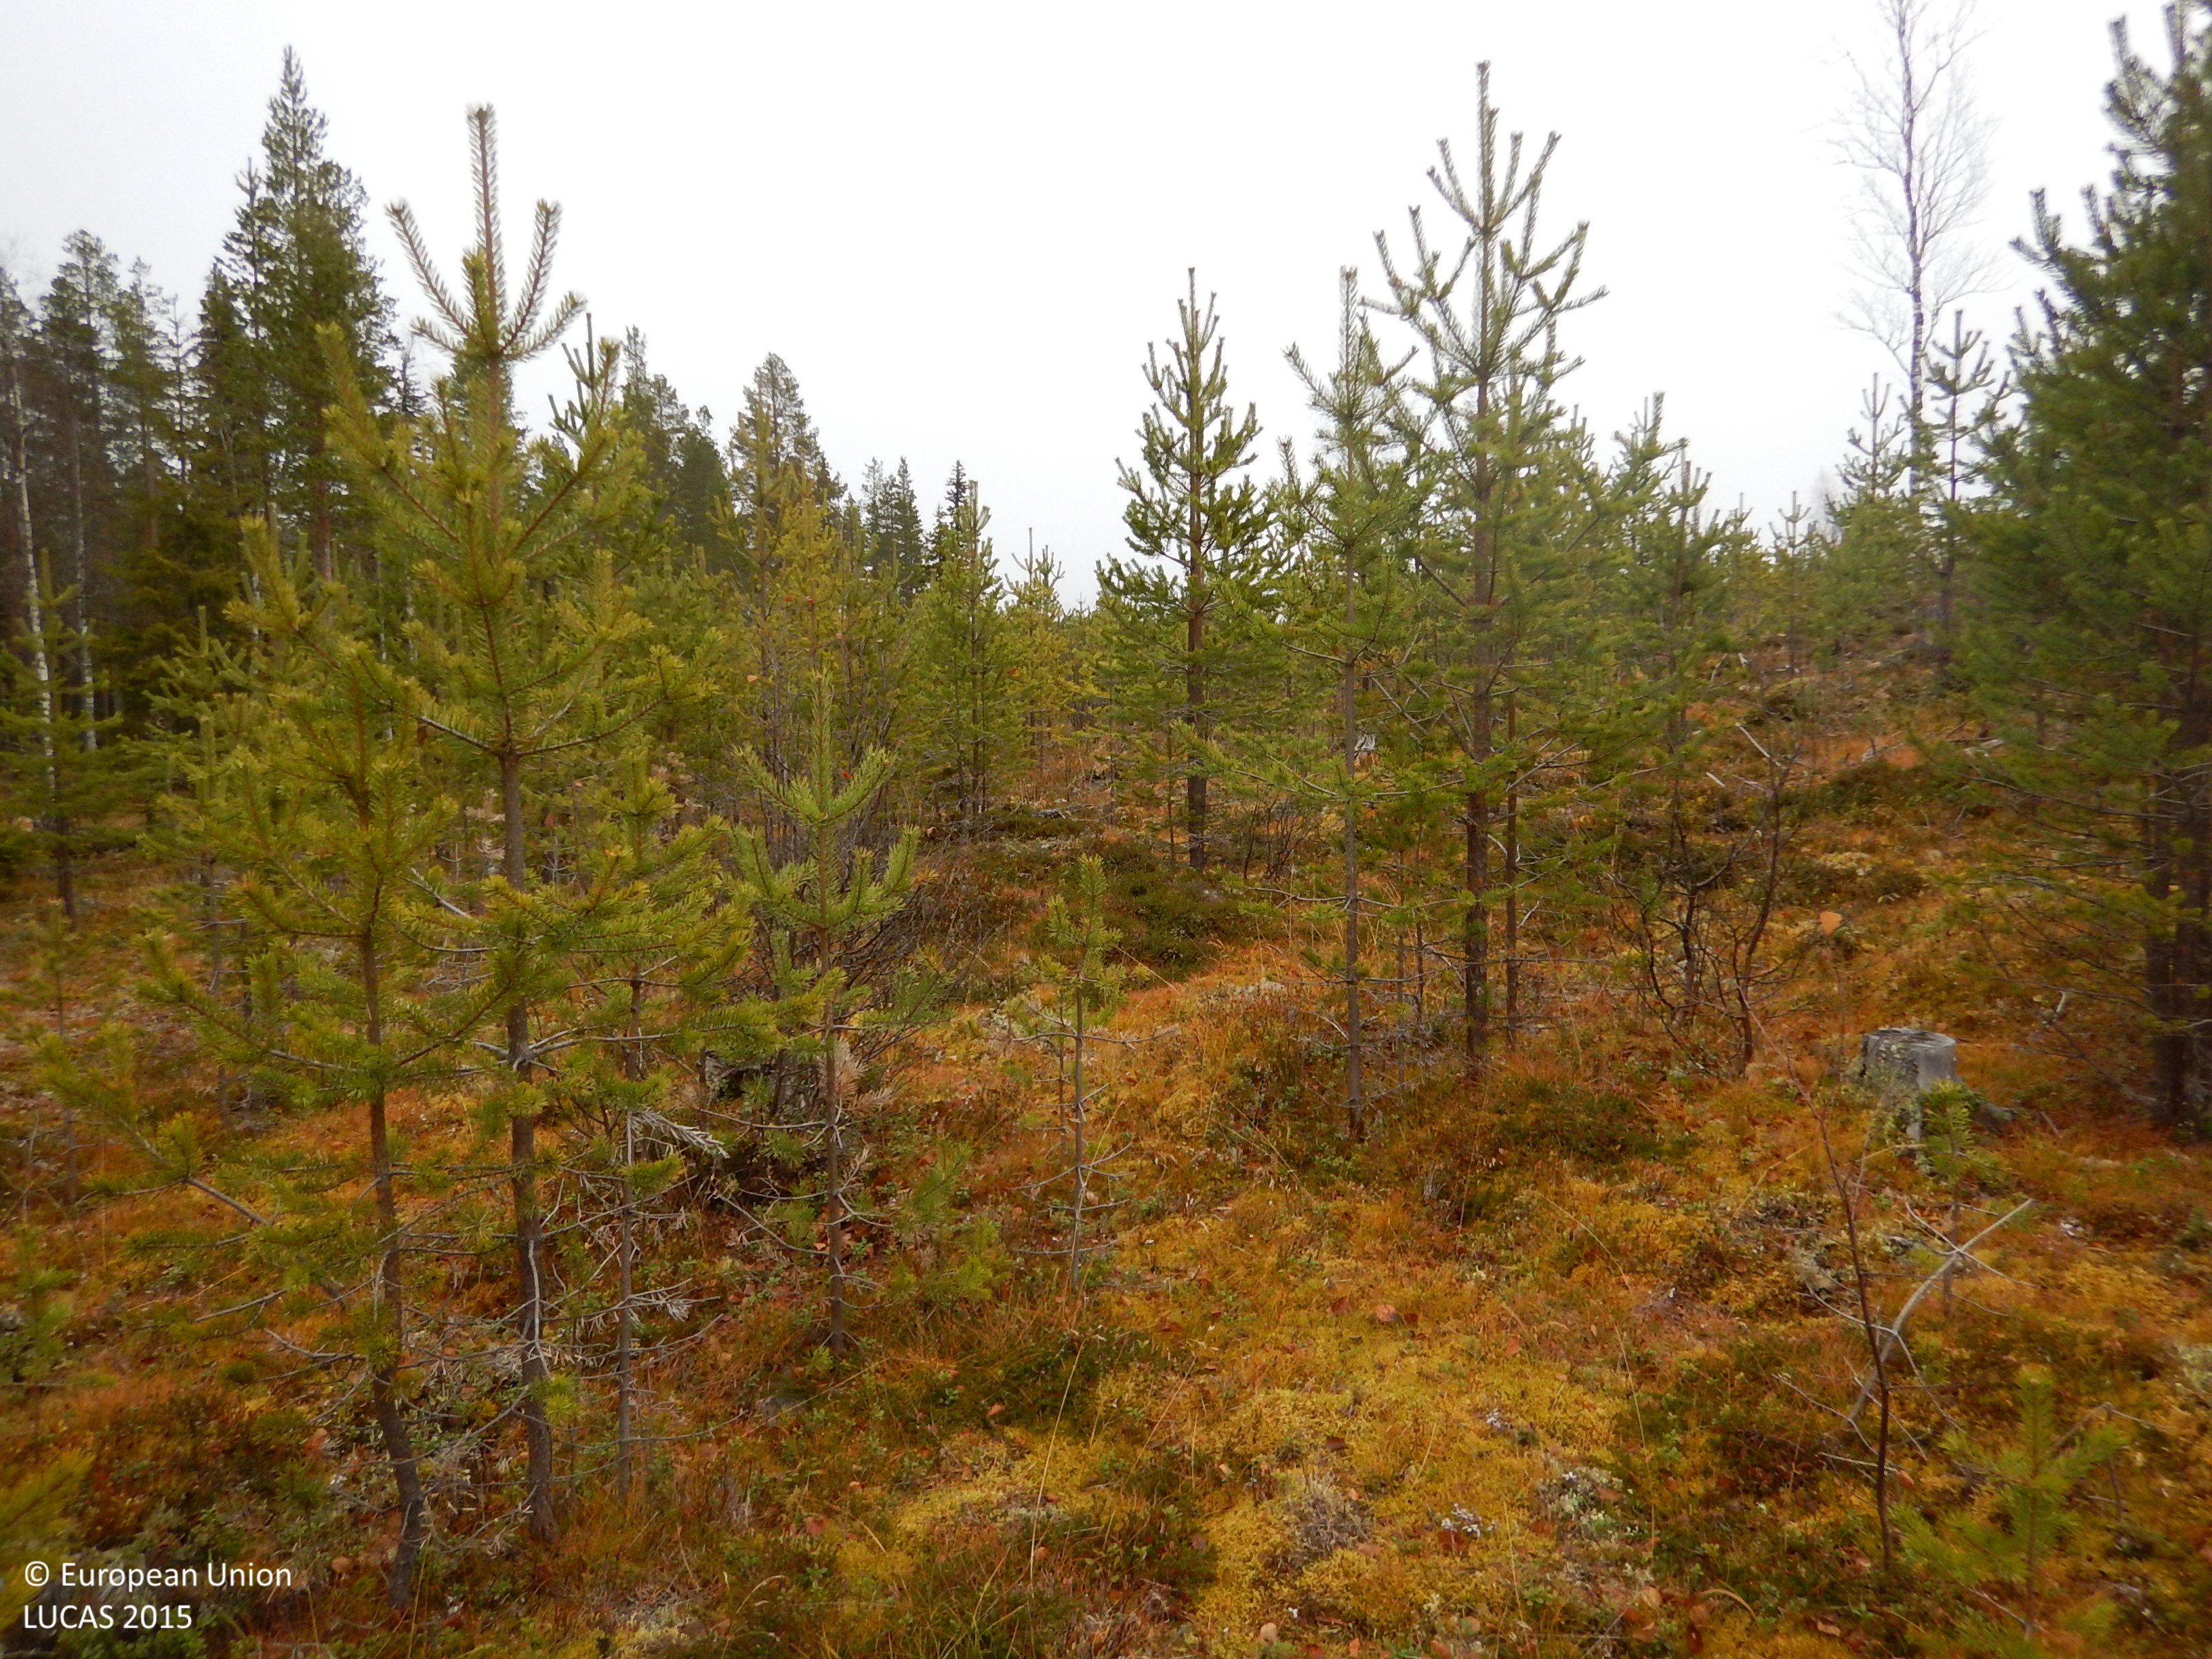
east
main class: Woodland
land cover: Pine dominated coniferous woodland
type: boreal forest
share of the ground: 50 - 75 %
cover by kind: coniferous forest trees 45 %, shrubs 20 %, herbaceous plants 15 %, lichens and mosses 15 %, broadleaved forest trees 5 %
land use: Forestry
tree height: < 5 m
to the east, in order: Pine dominated coniferous woodland
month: October
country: SE
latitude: 65.1643
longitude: 20.1895
